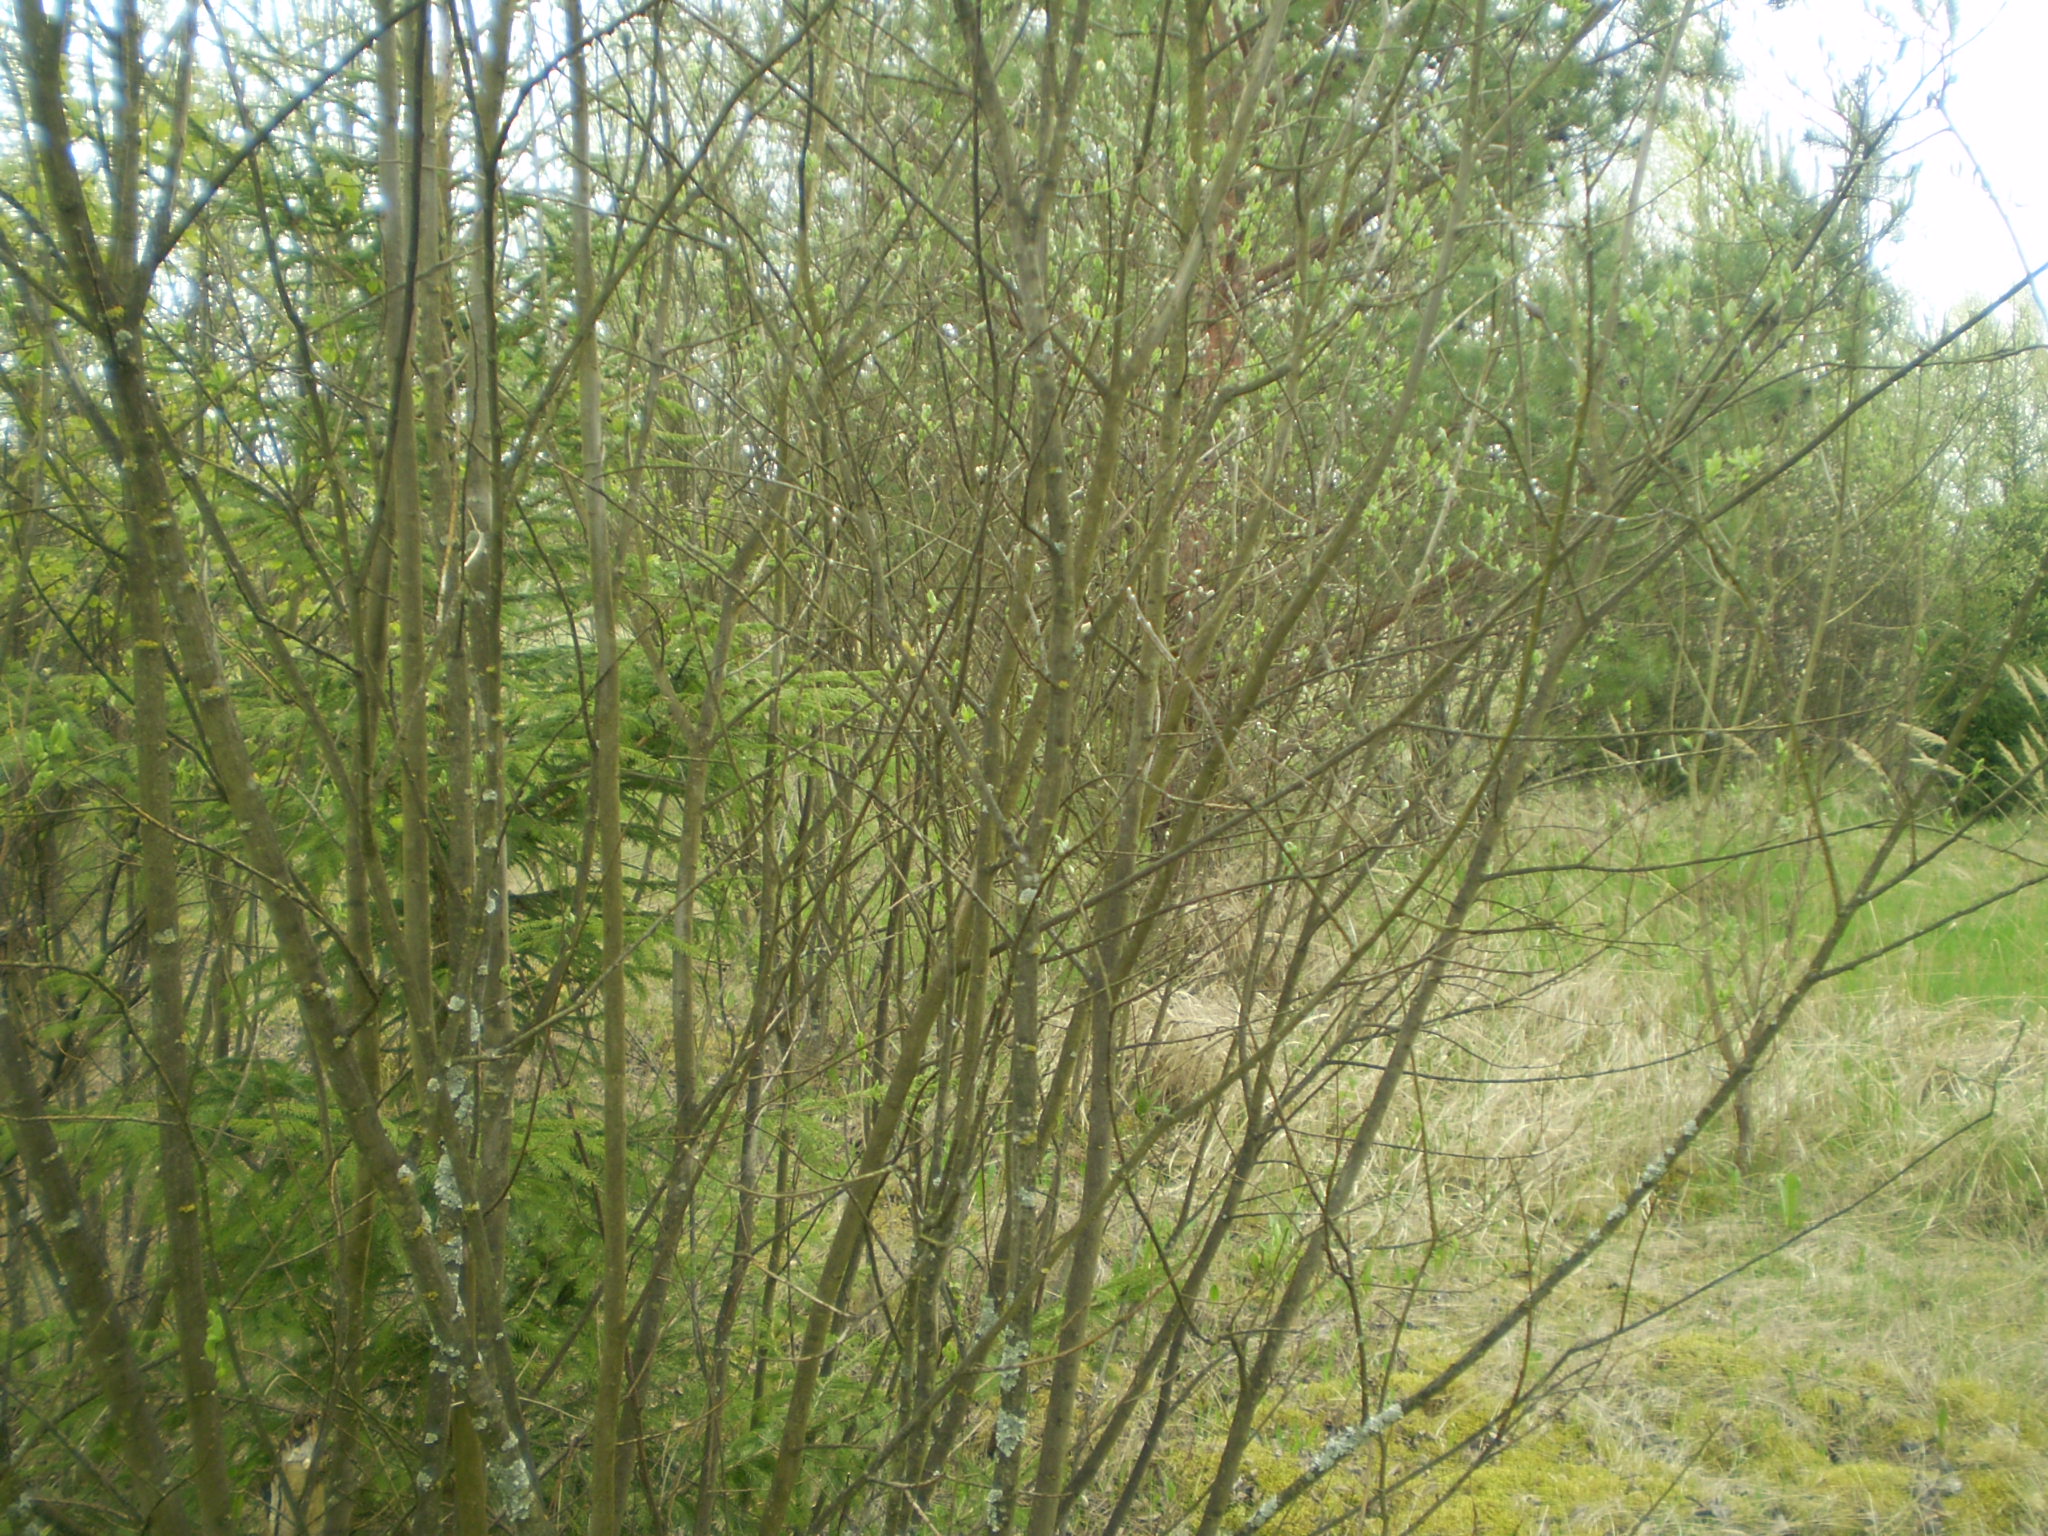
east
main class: Woodland
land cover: Other mixed woodland
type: hemiboreal forest and nemoral coniferous forest and mixed broadleaved-coniferous forest
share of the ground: > 75 %
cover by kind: broadleaved forest trees 65 %, coniferous forest trees 25 %, herbaceous plants 10 %
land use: Forestry
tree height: < 5 m
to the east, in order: Other mixed woodland; Spontaneously vegetated surfaces; Shrubland with sparse tree cover; Grassland without tree/shrub cover; Spontaneously vegetated surfaces; Broadleaved woodland; Spontaneously vegetated surfaces; Grassland with sparse tree/shrub cover
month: May
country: LT
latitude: 56.3905
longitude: 22.1525
